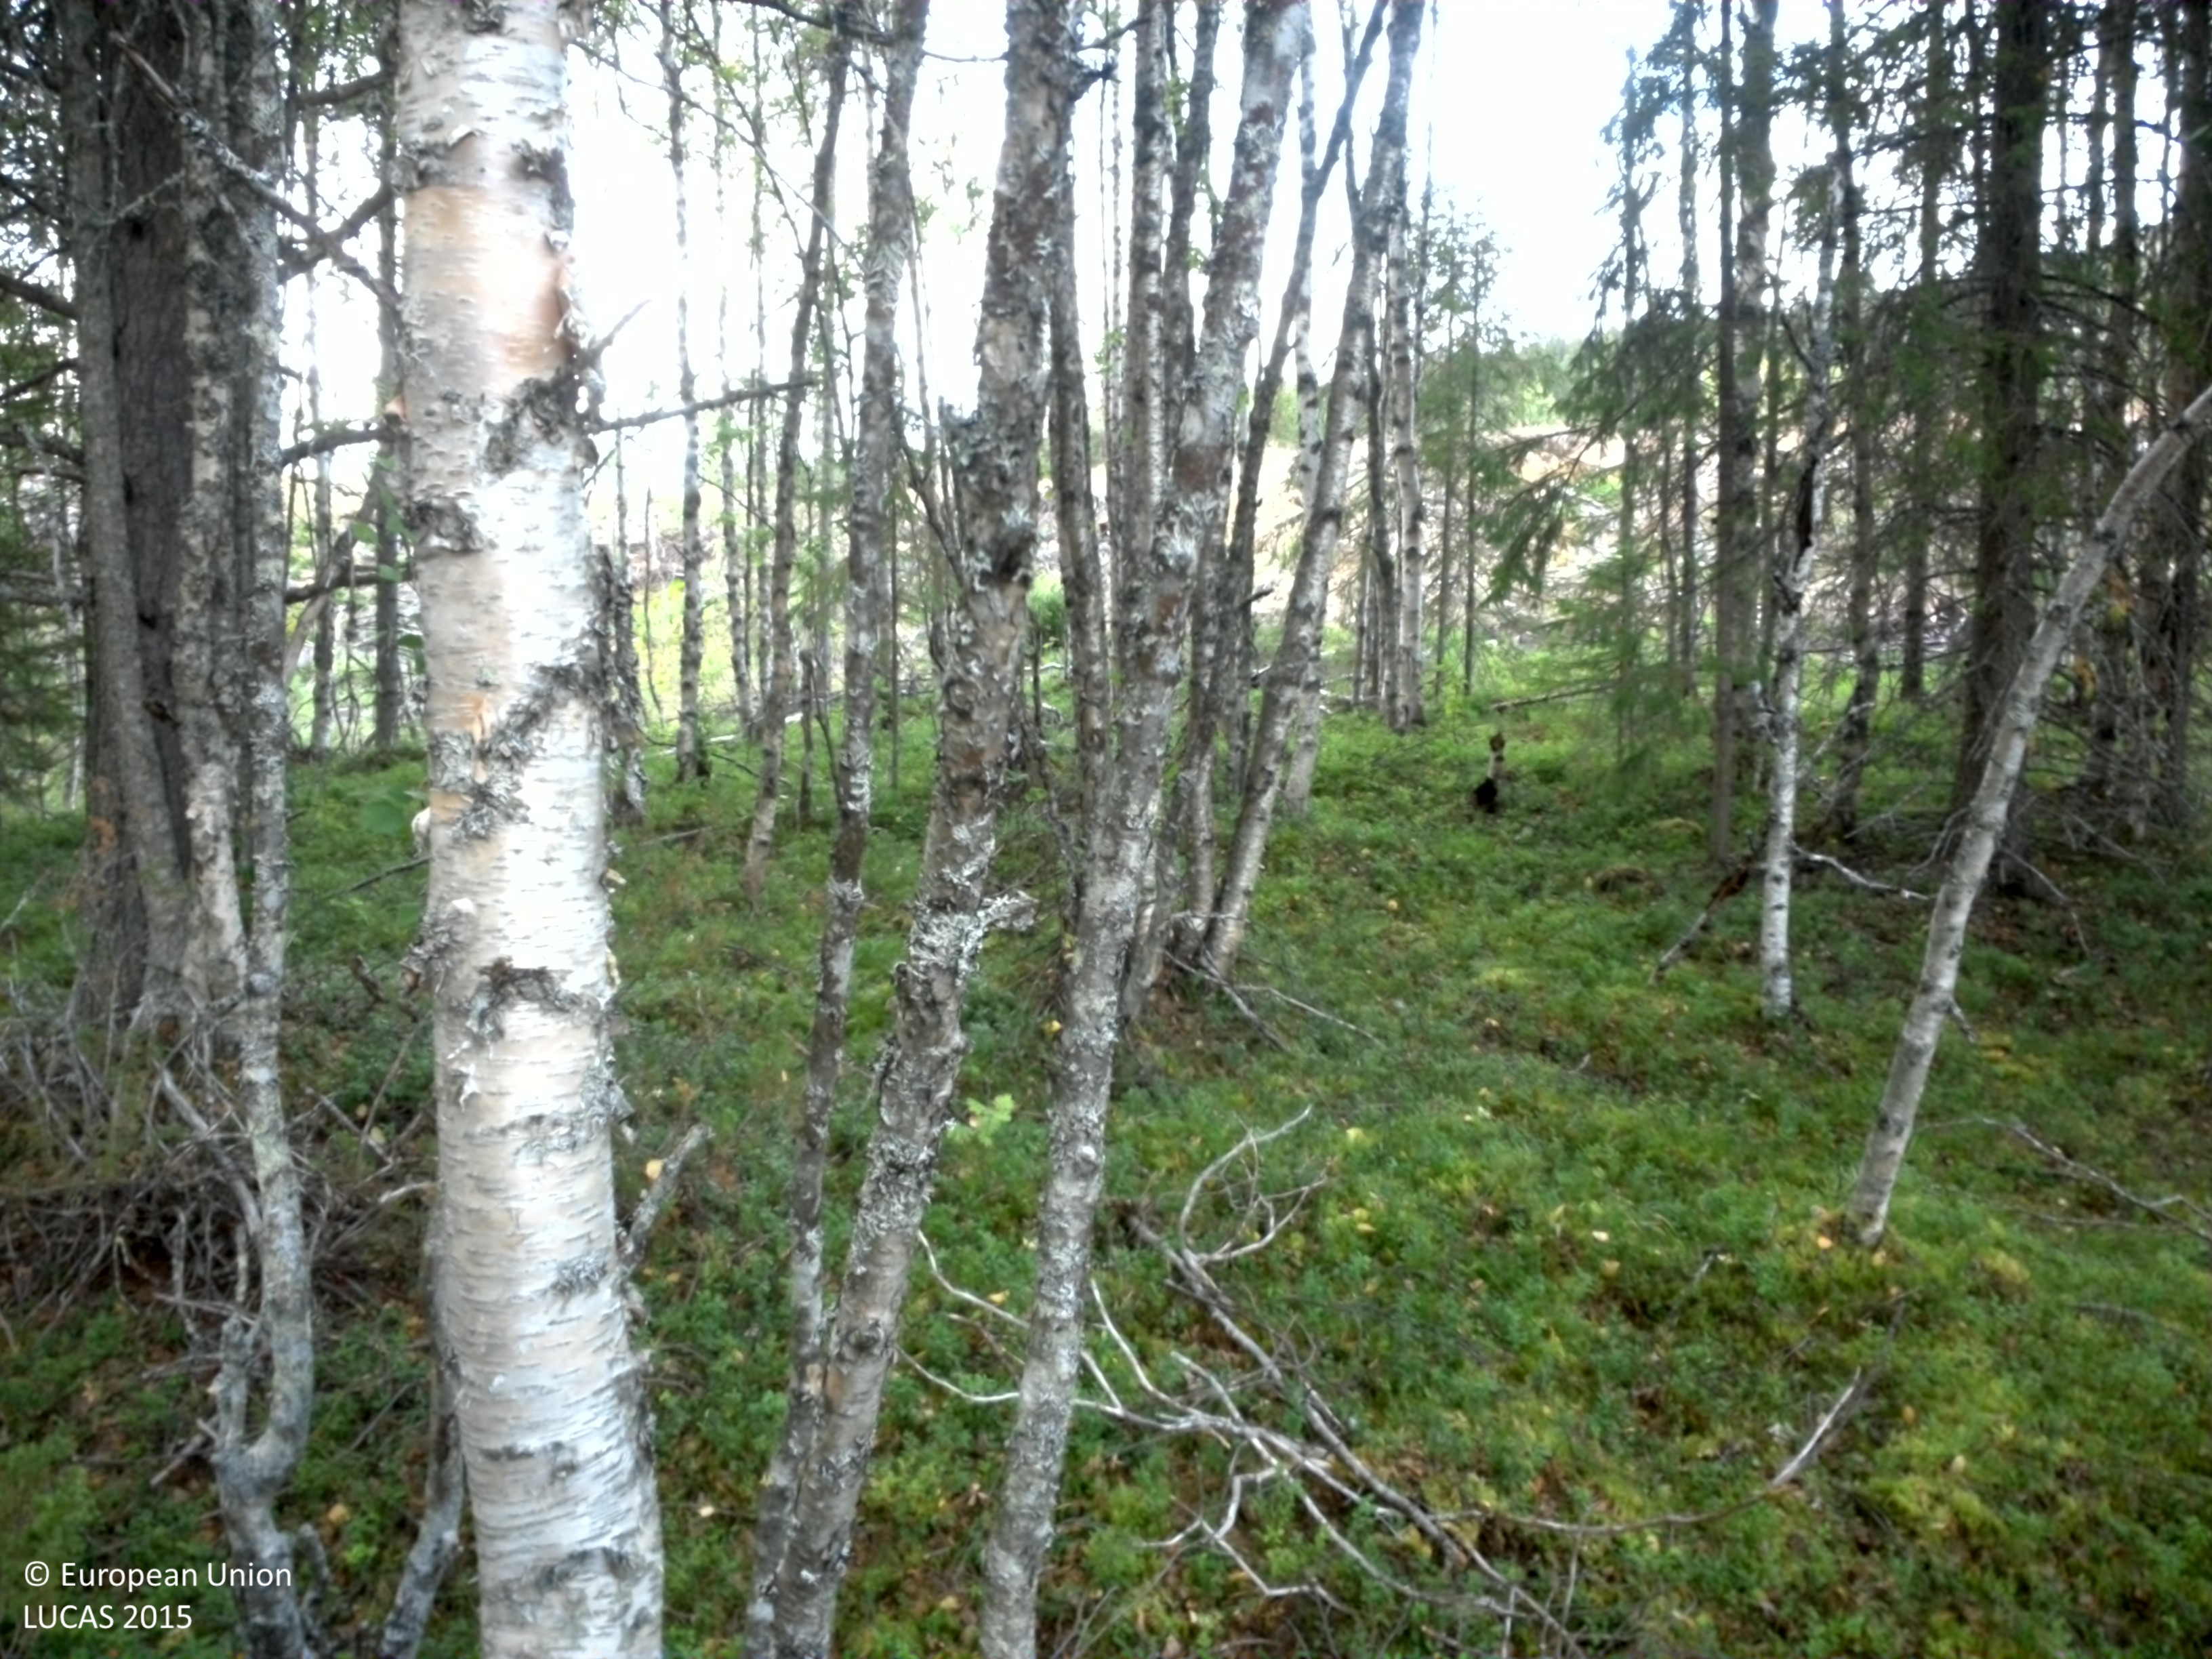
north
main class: Woodland
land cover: Spruce dominated mixed woodland
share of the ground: 50 - 75 %
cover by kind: broadleaved forest trees 45 %, shrubs 20 %, coniferous forest trees 15 %, lichens and mosses 15 %, herbaceous plants 5 %
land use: Forestry
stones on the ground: < 10 %
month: August
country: SE
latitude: 65.0059
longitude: 16.5613
